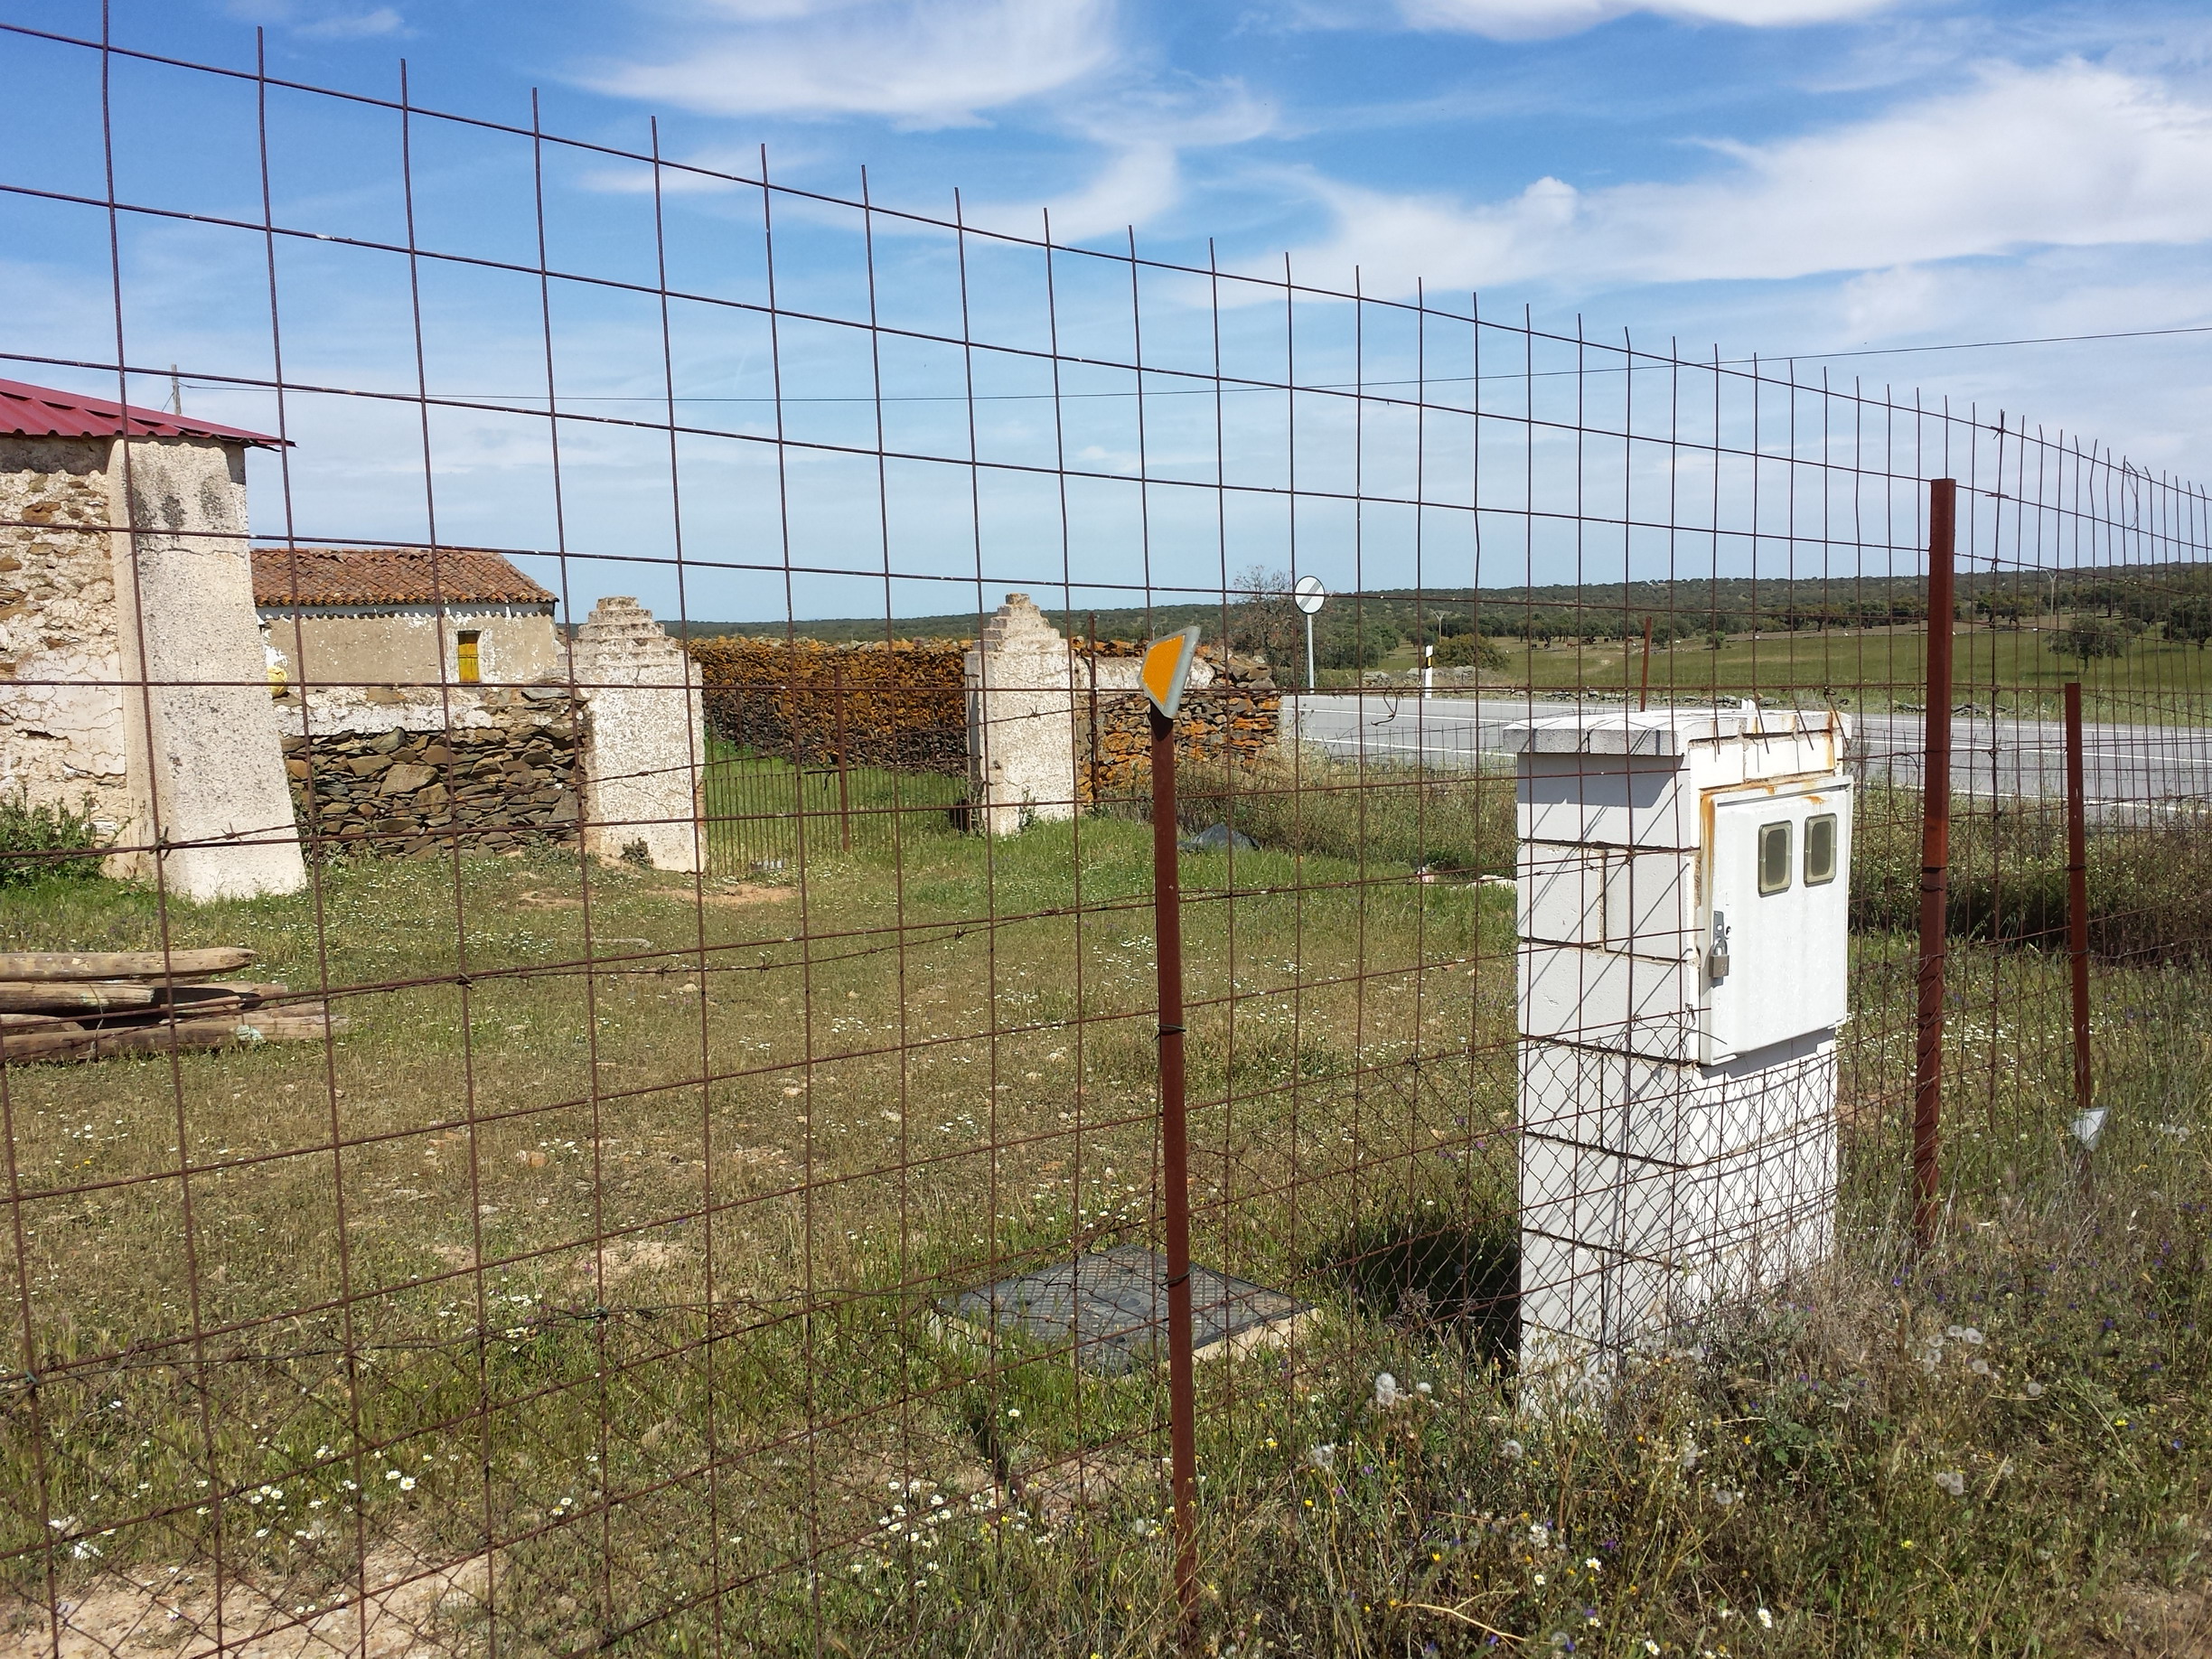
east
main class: Woodland
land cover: Broadleaved woodland
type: broadleaved evergreen forest
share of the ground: 25 - 50 %
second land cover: Grassland without tree/shrub cover
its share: > 75 %
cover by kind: herbaceous plants 65 %, broadleaved forest trees 35 %
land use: Forestry
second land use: Agriculture (excluding fallow land and kitchen gardens)
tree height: > 5 m
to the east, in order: Broadleaved woodland; Grassland without tree/shrub cover; Rivers and streams; Broadleaved woodland; Fences; Other structural elements; Broadleaved woodland
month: May
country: ES
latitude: 39.5152
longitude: -7.1726
